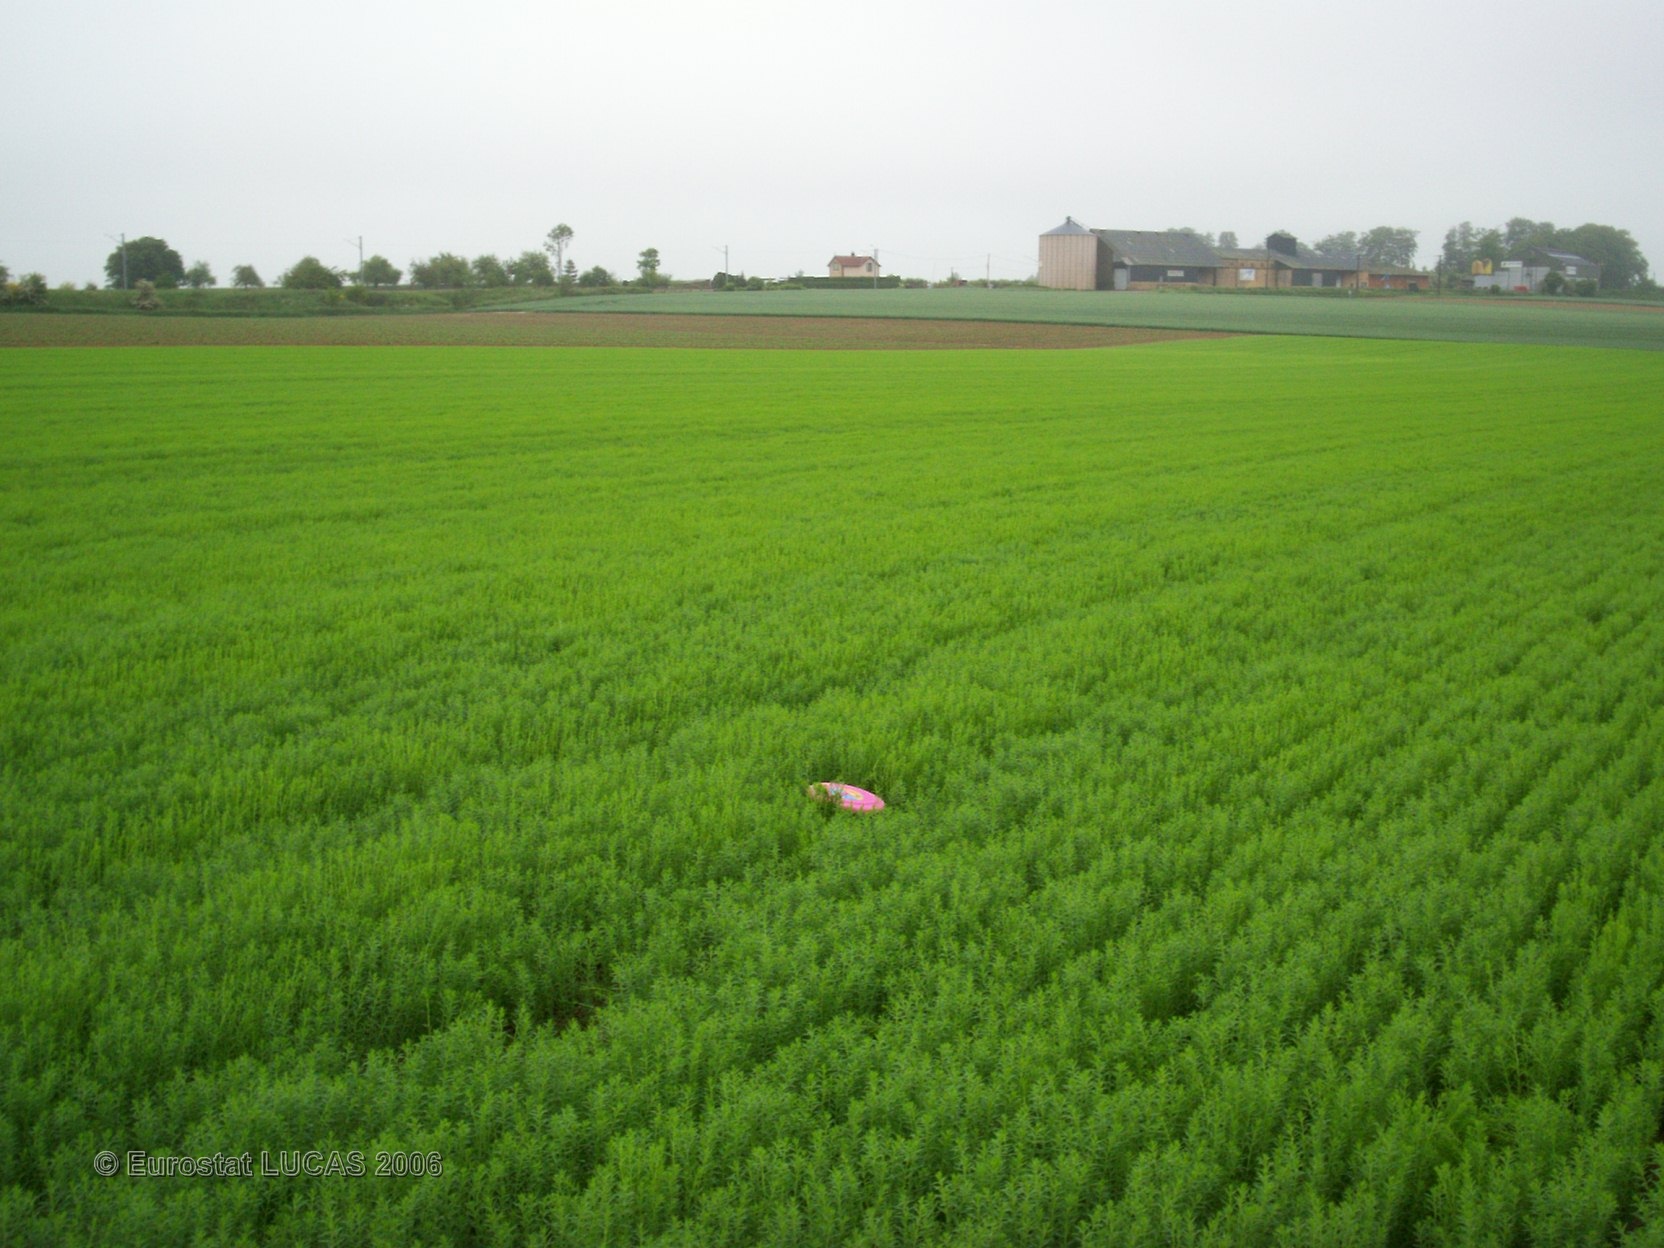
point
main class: Cropland
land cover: Other fibre and oleaginous crops
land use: Agriculture (excluding fallow land and kitchen gardens)
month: May
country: FR
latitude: 49.6392
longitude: 0.9067
